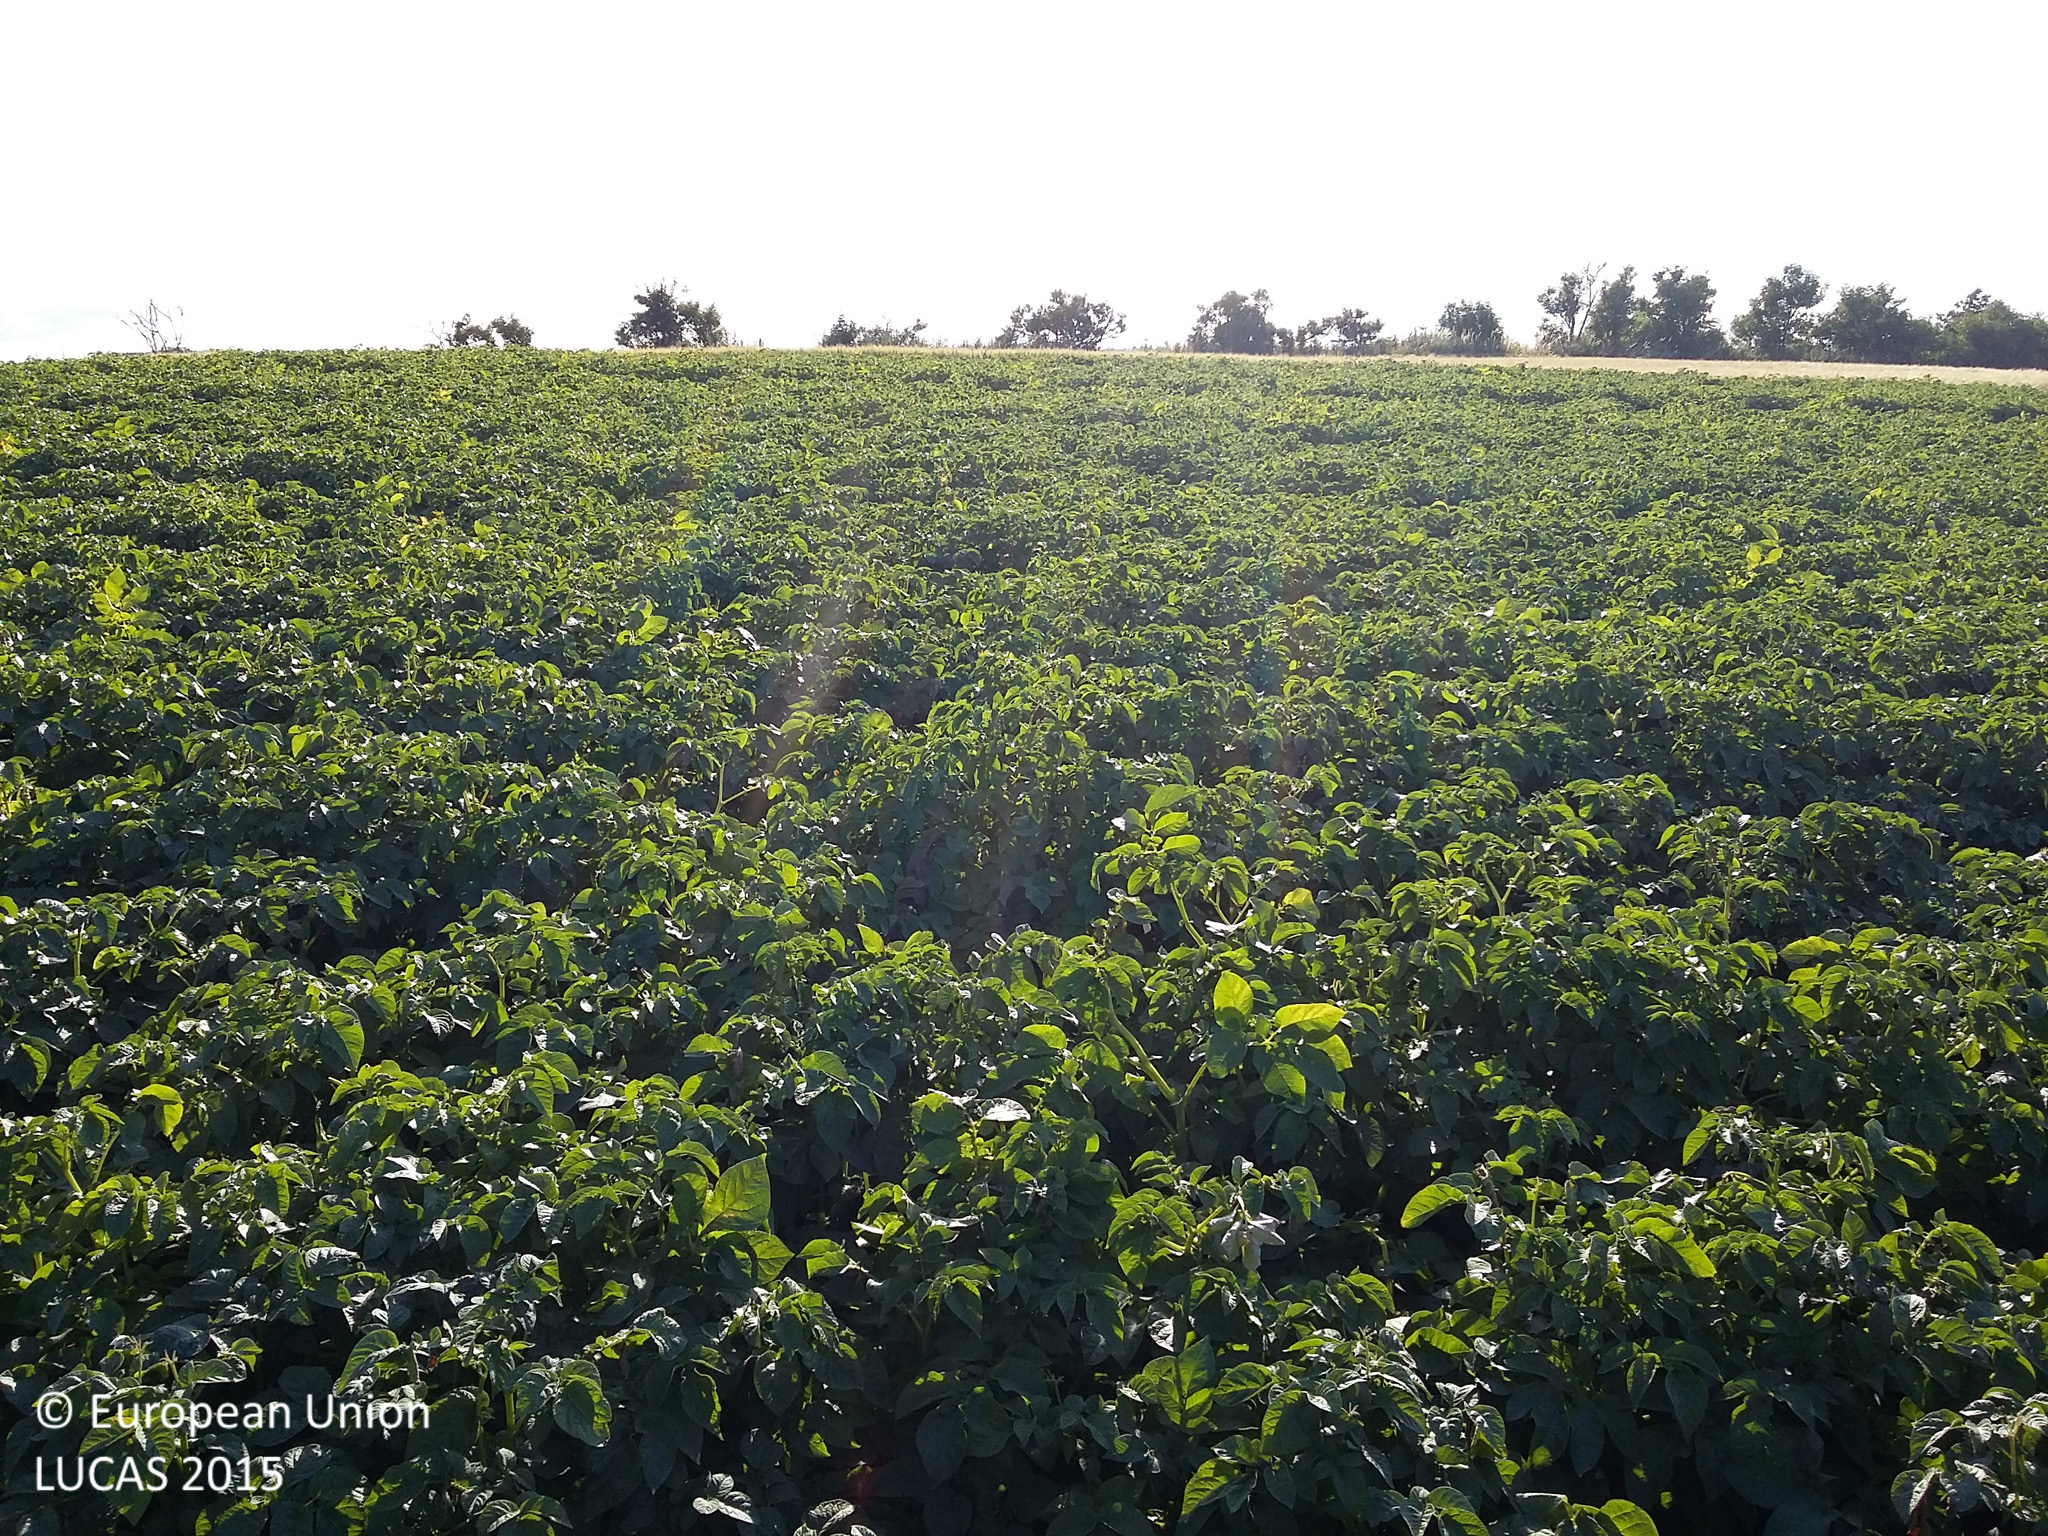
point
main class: Cropland
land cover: Potatoes
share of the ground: > 75 %
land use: Agriculture (excluding fallow land and kitchen gardens)
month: July
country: DK
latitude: 55.7668
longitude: 11.3853
